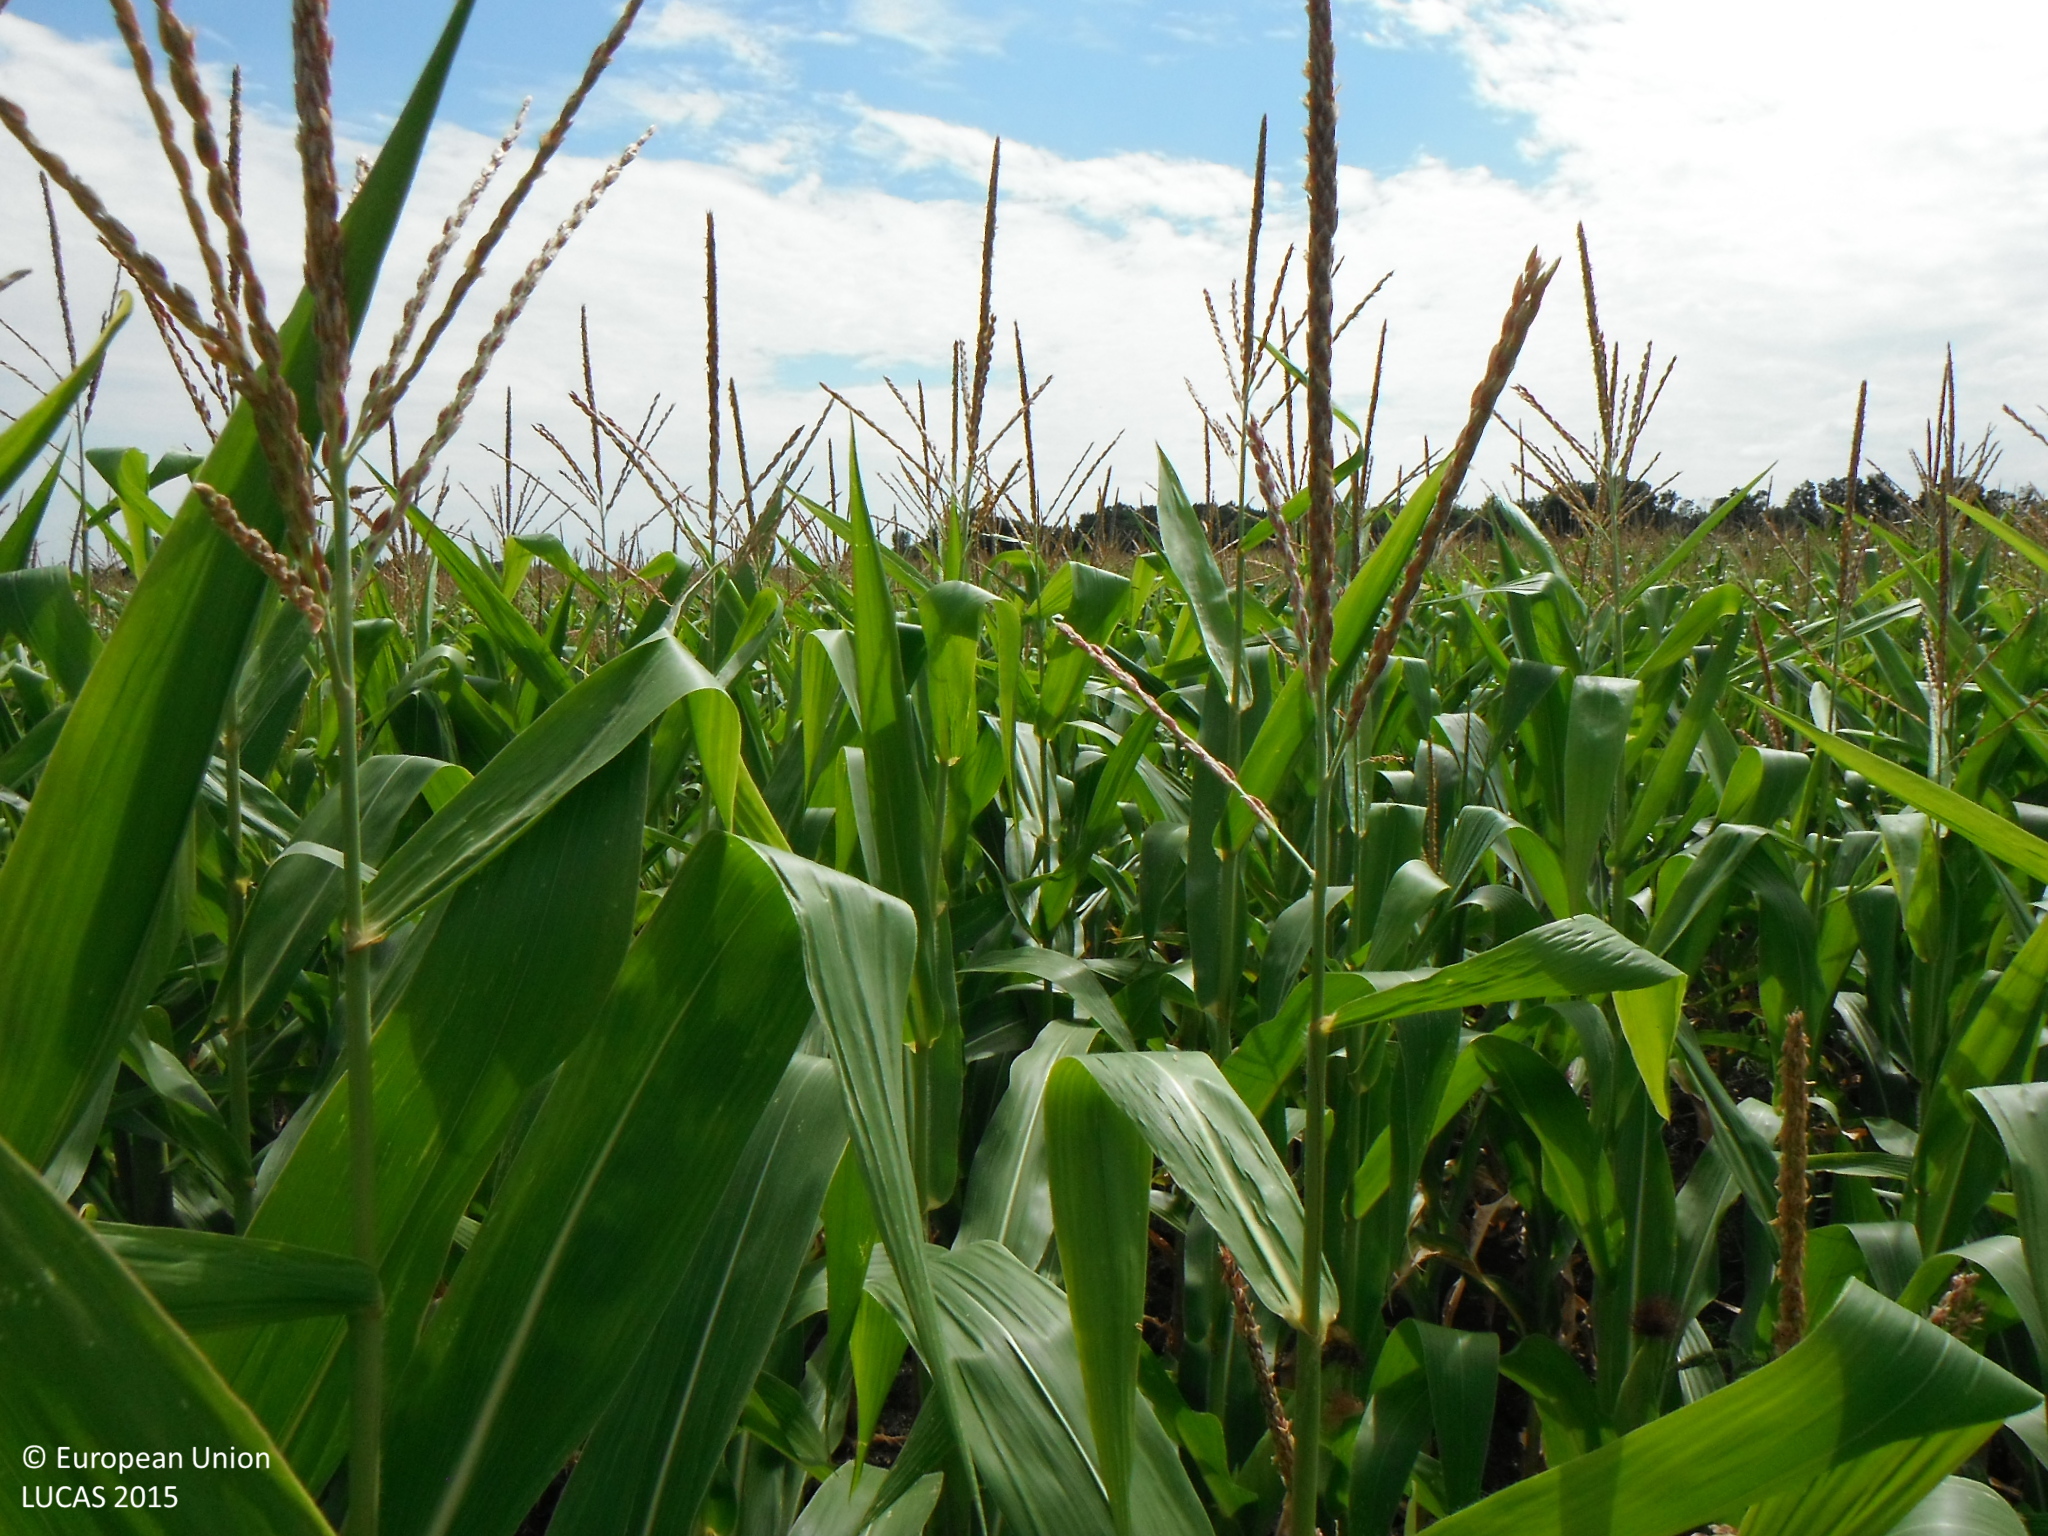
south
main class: Cropland
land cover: Maize
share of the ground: > 75 %
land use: Agriculture (excluding fallow land and kitchen gardens)
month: July
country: SK
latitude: 48.1151
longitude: 18.2212
